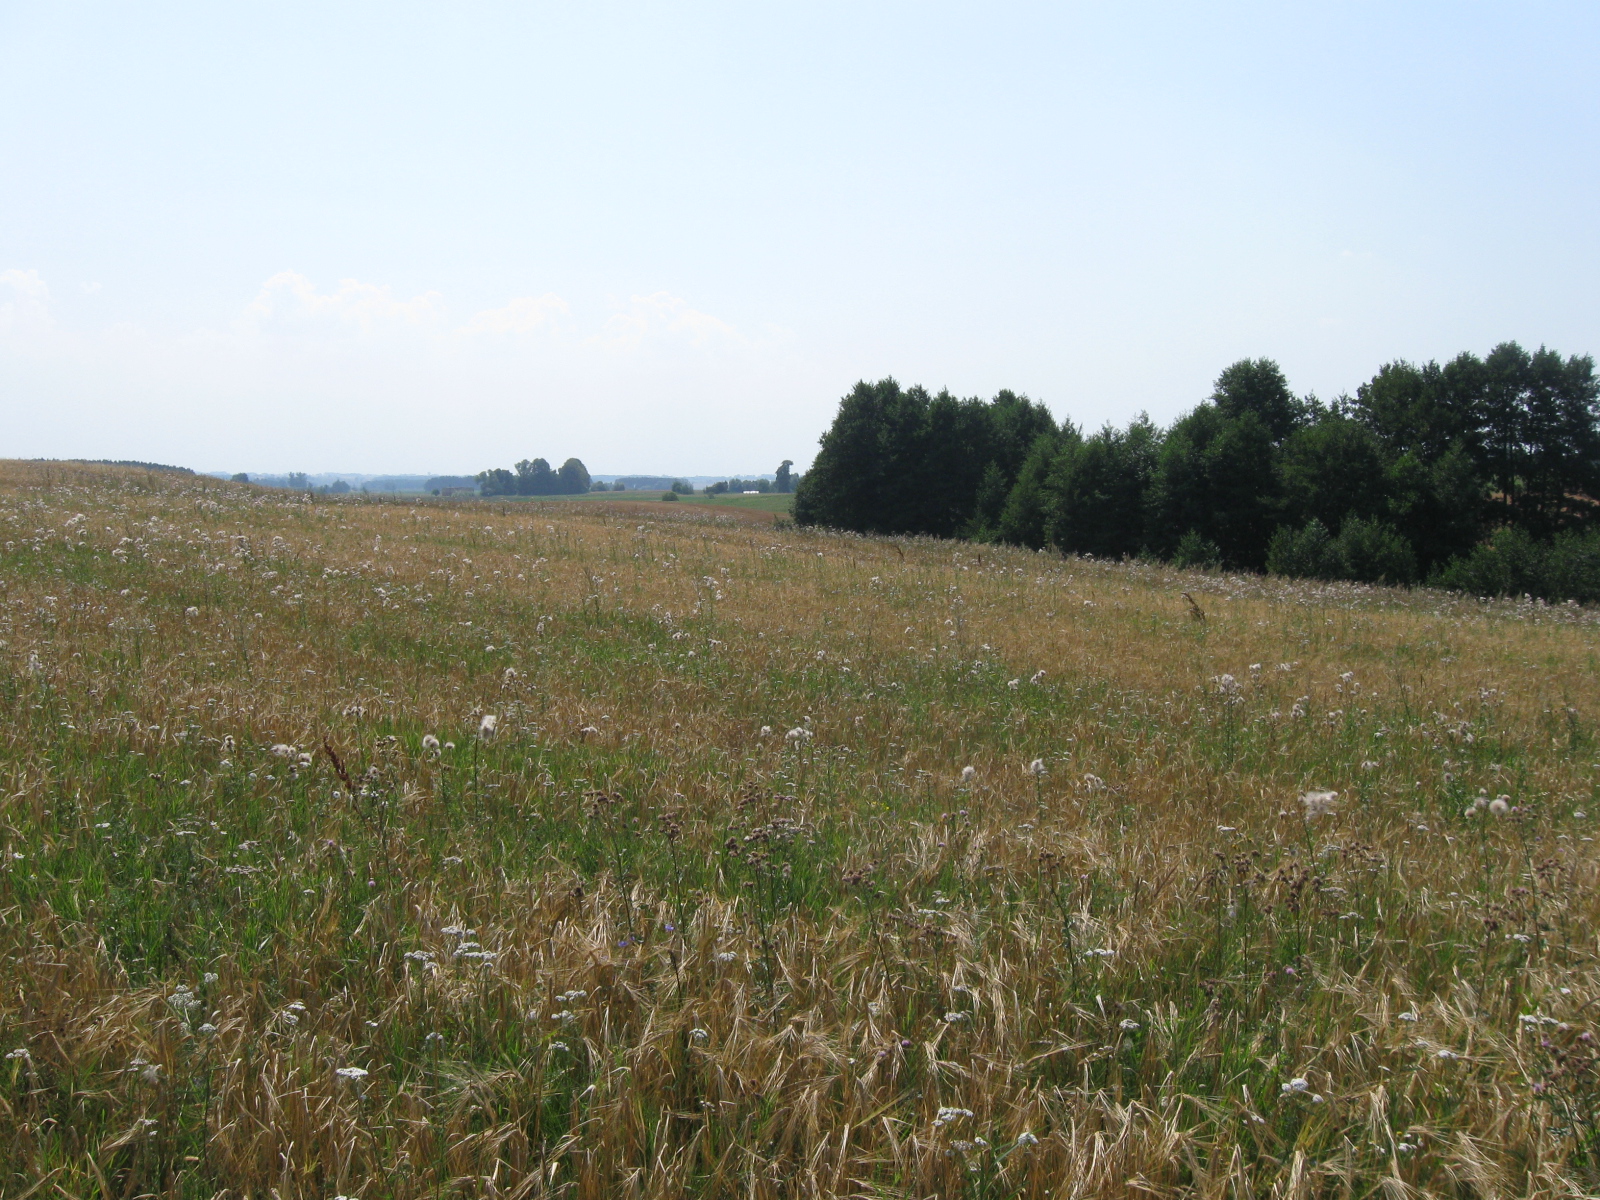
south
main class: Cropland
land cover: Barley
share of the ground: 50 - 75 %
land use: Agriculture (excluding fallow land and kitchen gardens)
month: August
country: LT
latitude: 54.3846
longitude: 23.2425
